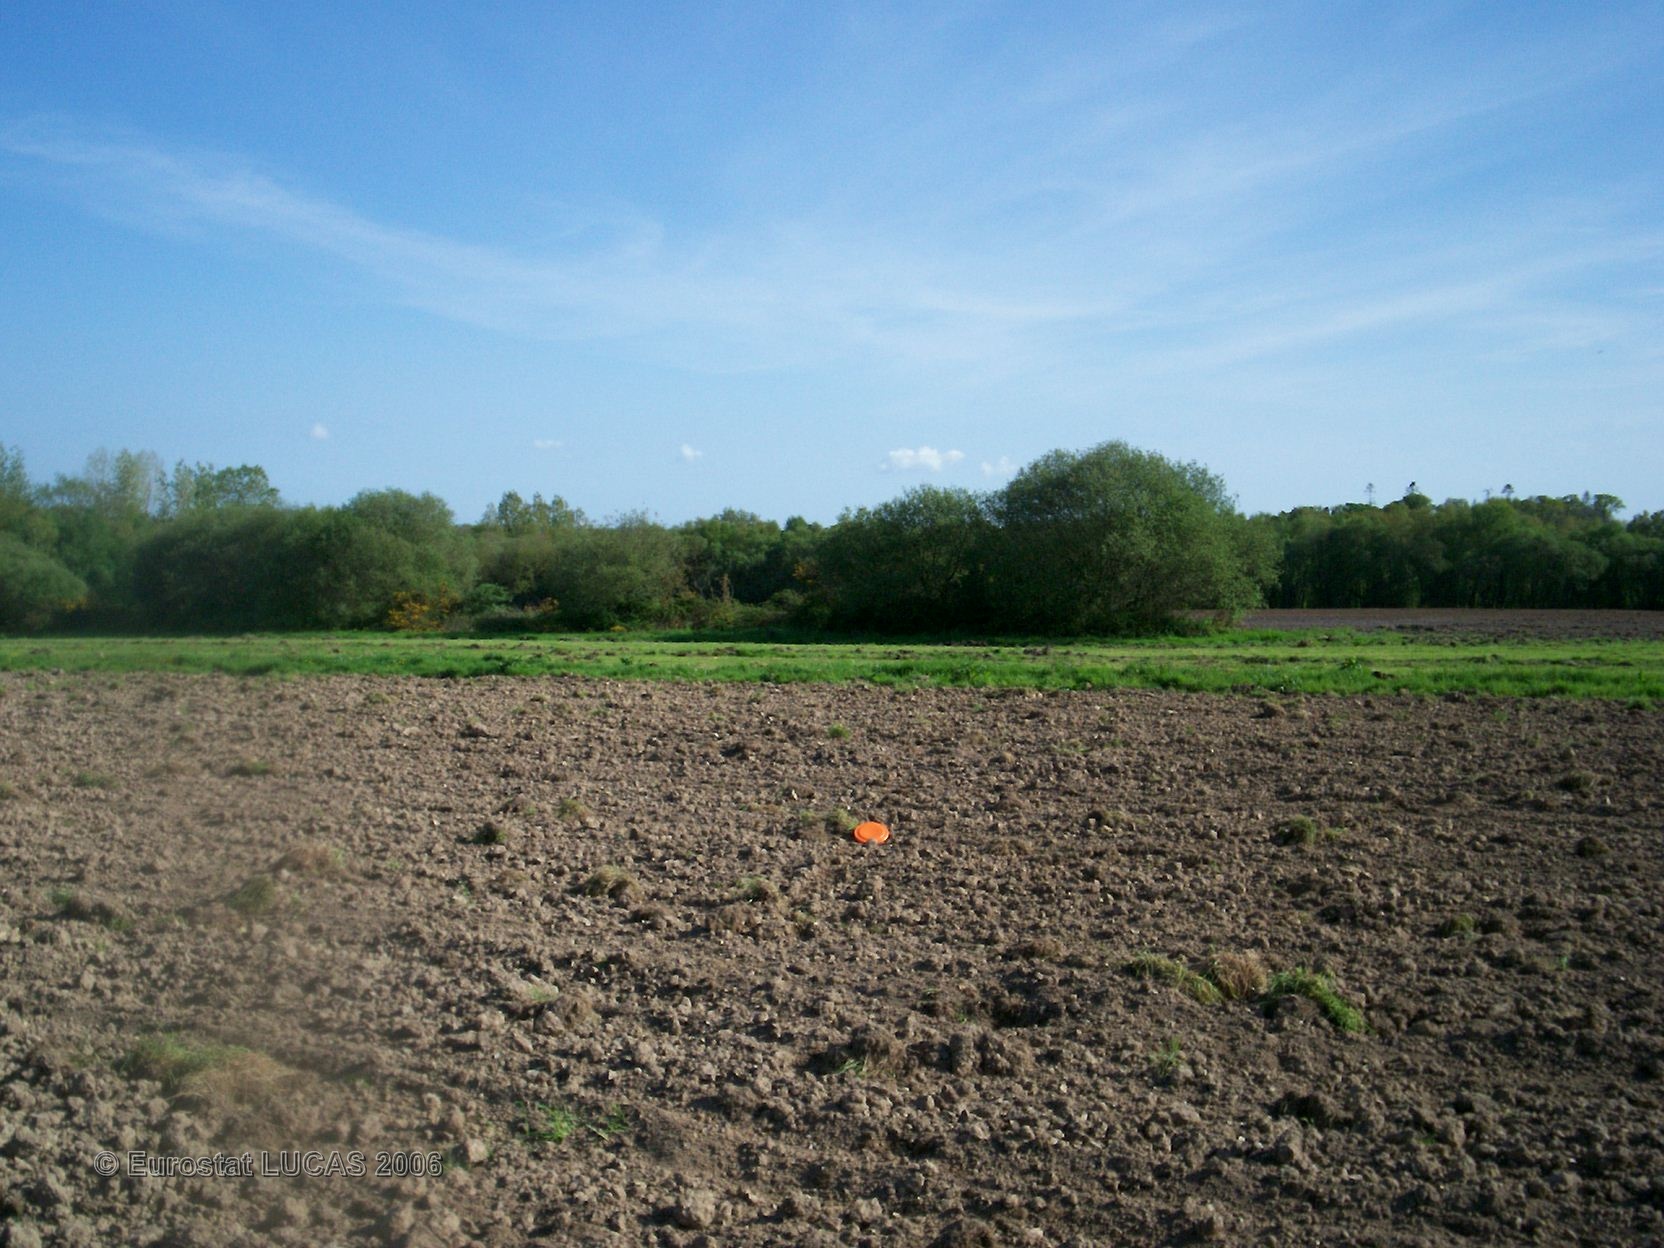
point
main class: Cropland
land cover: Maize
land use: Agriculture (excluding fallow land and kitchen gardens)
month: May
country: FR
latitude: 48.0059
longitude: -2.9210
